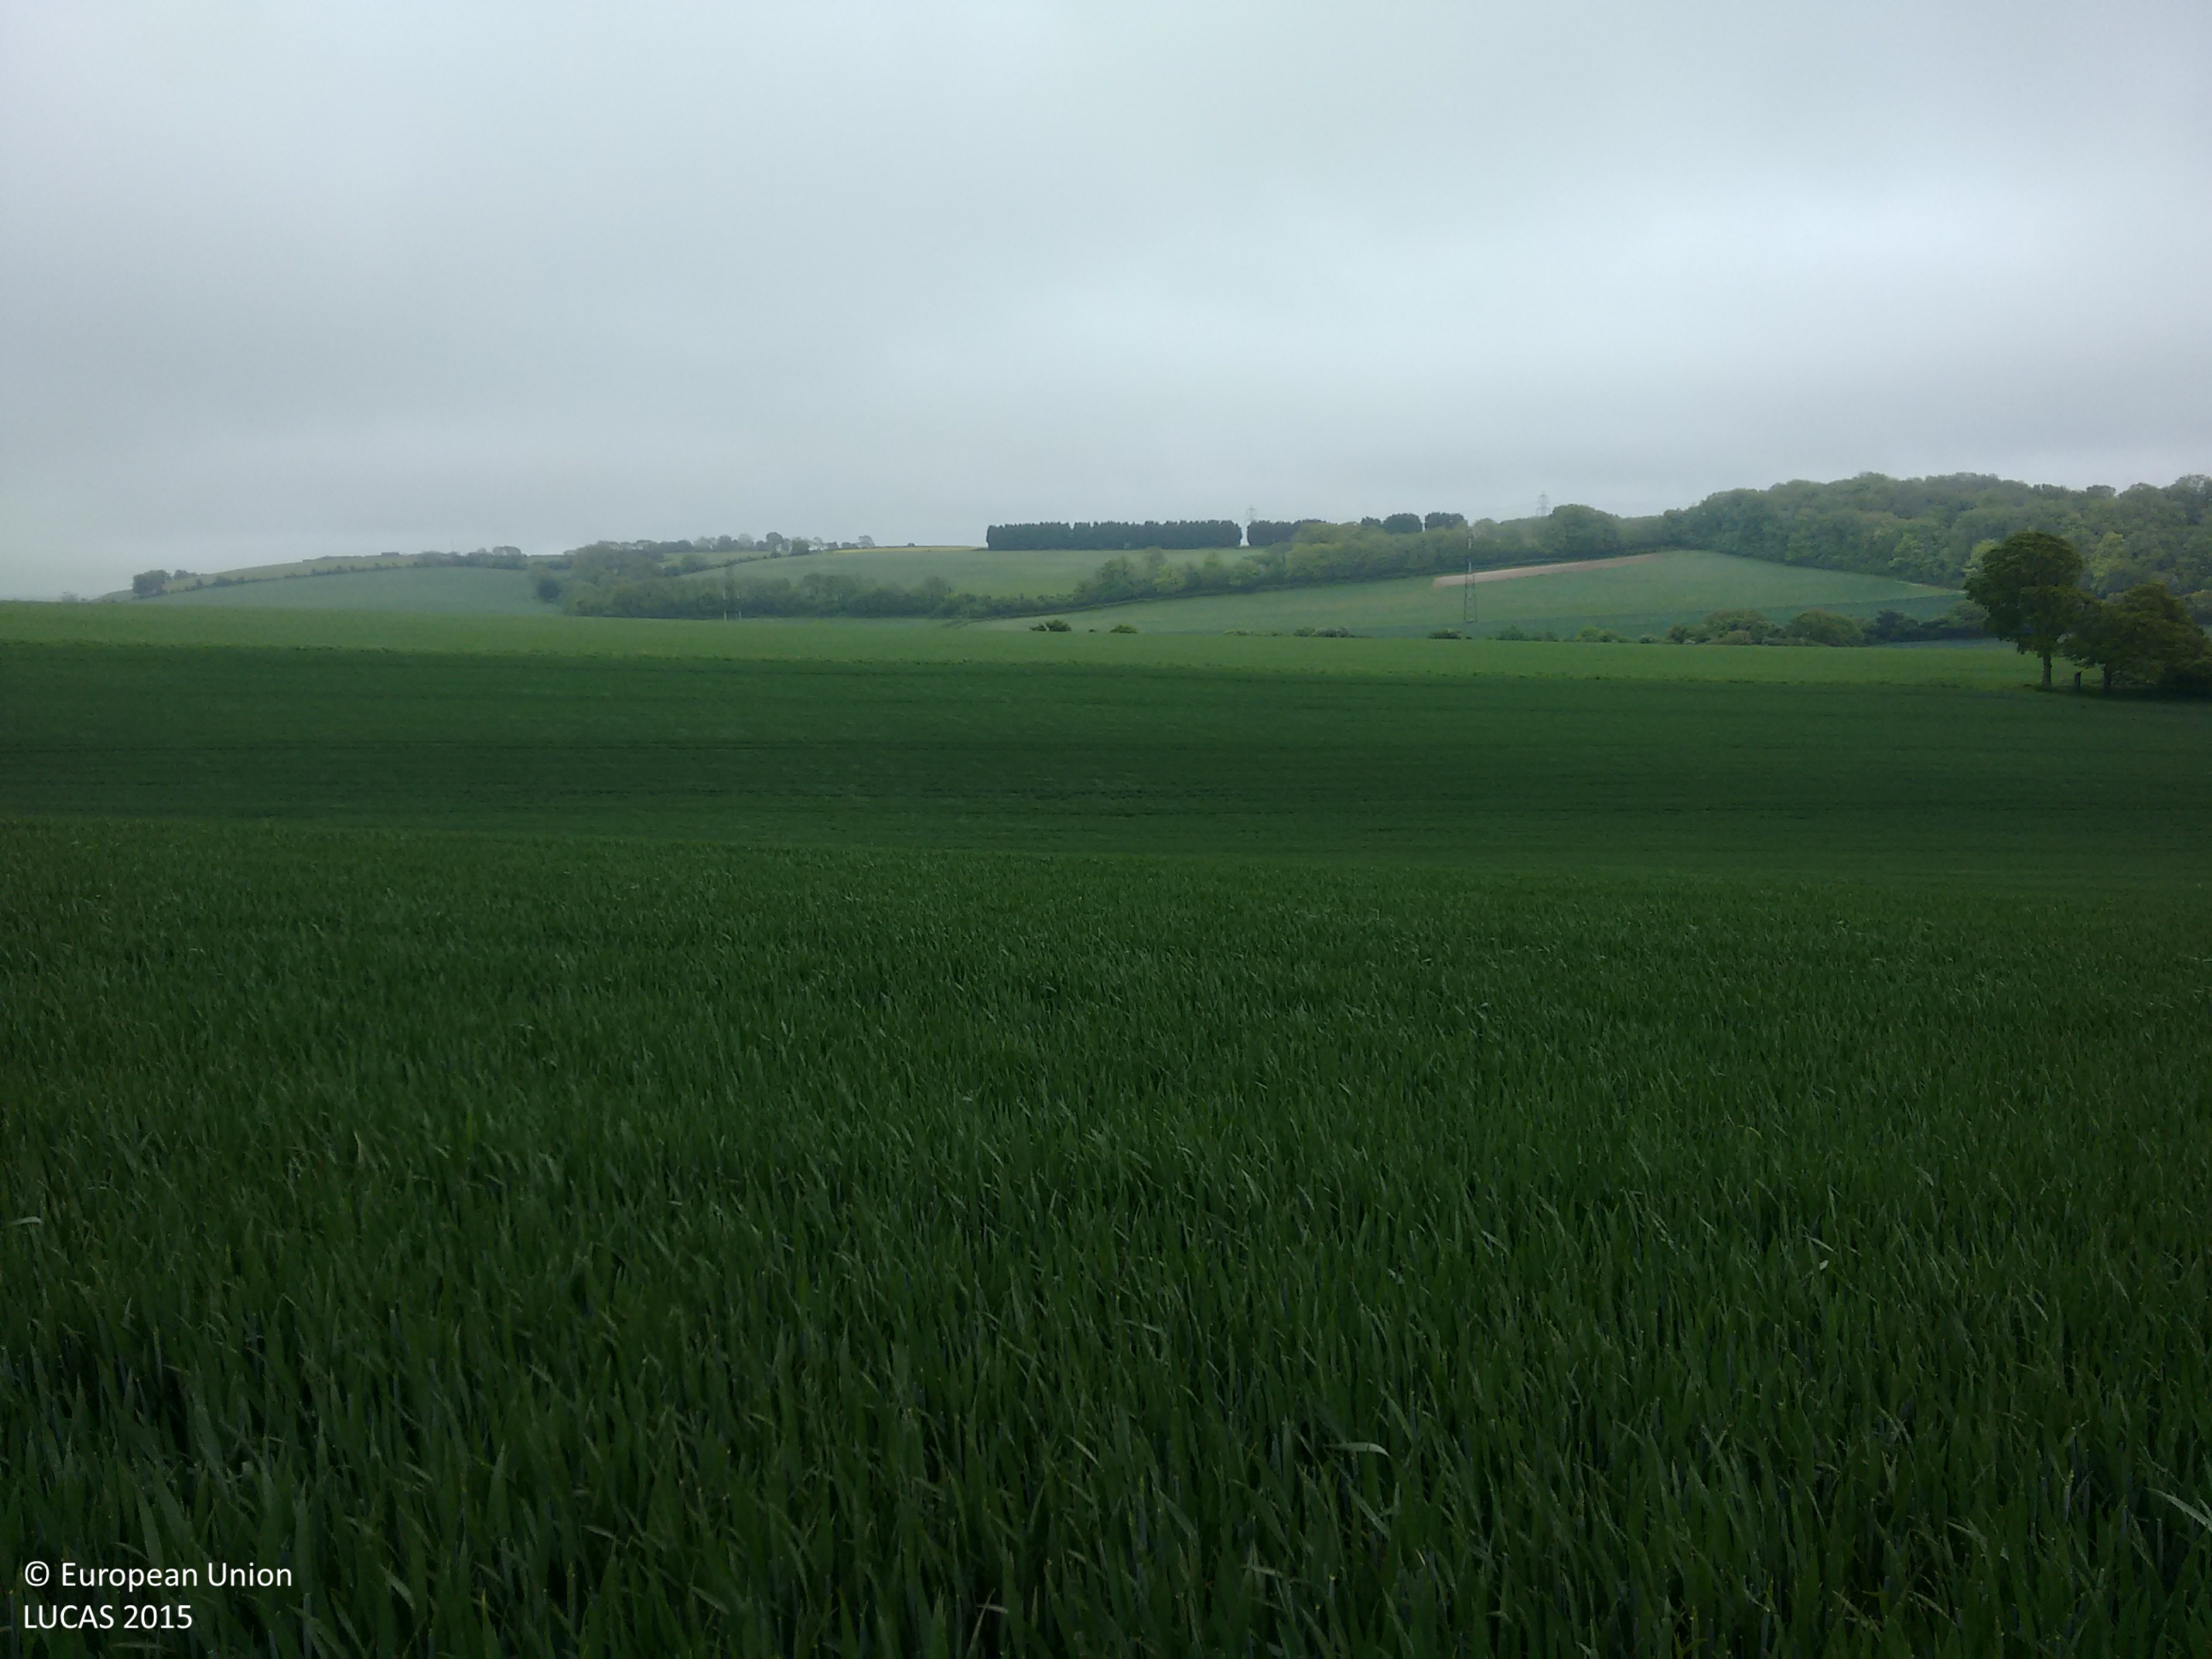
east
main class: Cropland
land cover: Common wheat
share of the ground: > 75 %
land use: Agriculture (excluding fallow land and kitchen gardens)
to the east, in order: Common wheat; Grass margins; Barley
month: May
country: GB
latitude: 50.9347
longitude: -1.0445
